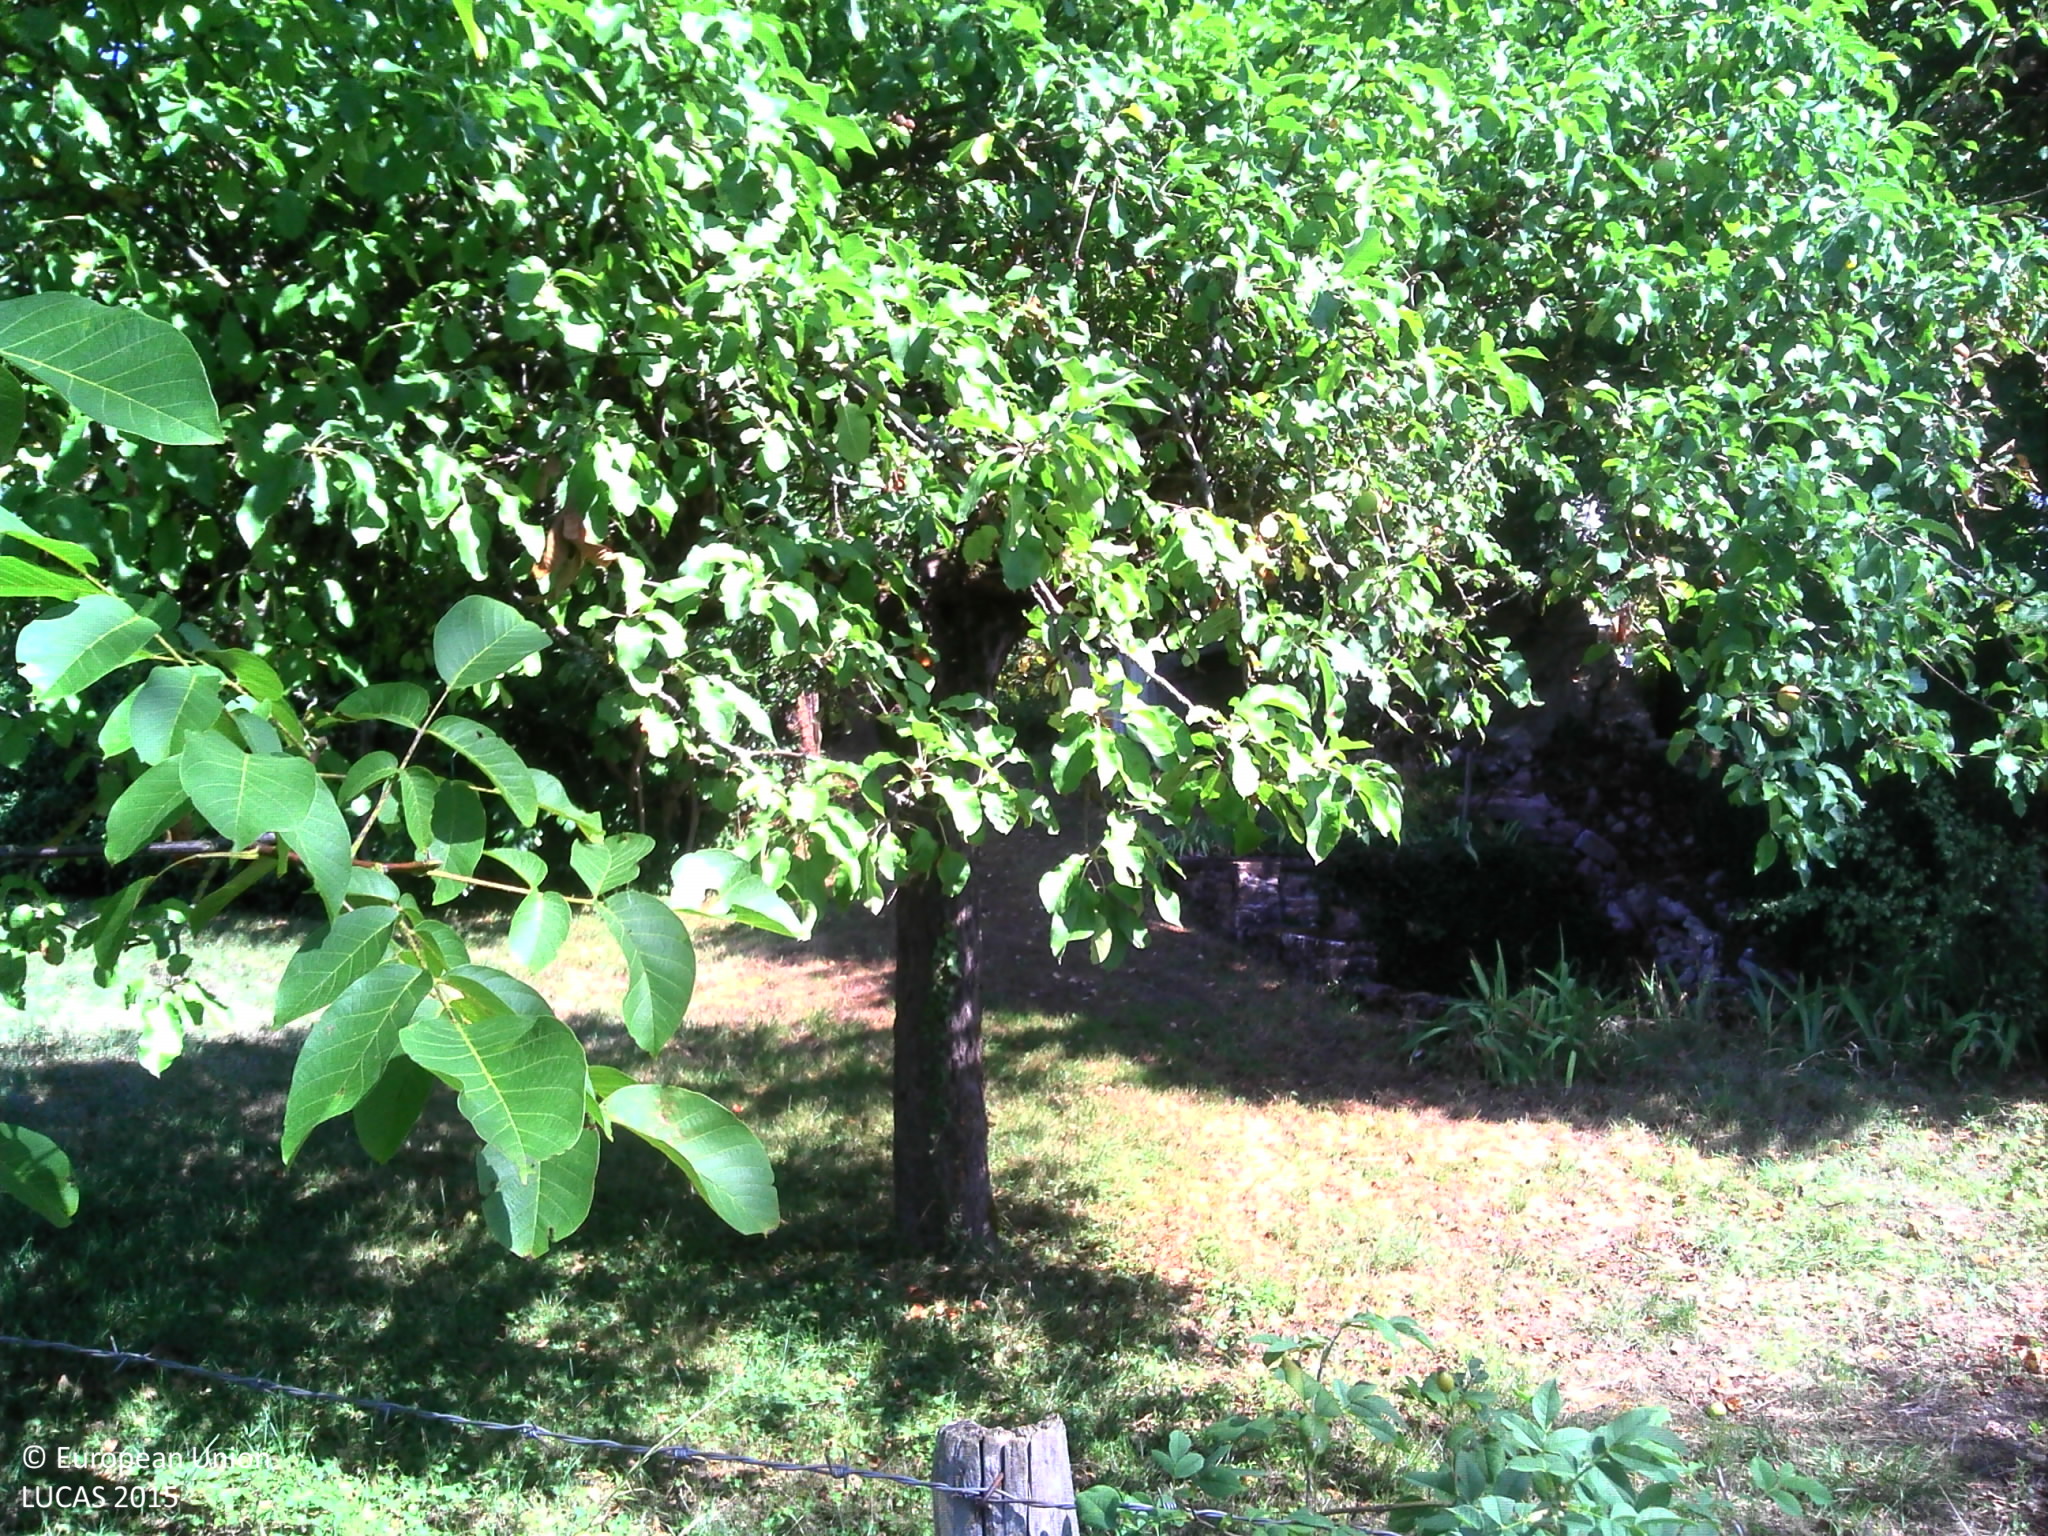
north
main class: Cropland
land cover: Apple fruit
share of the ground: > 75 %
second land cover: Grassland without tree/shrub cover
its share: > 75 %
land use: Kitchen garden
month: August
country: FR
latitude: 46.3327
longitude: 4.7930
